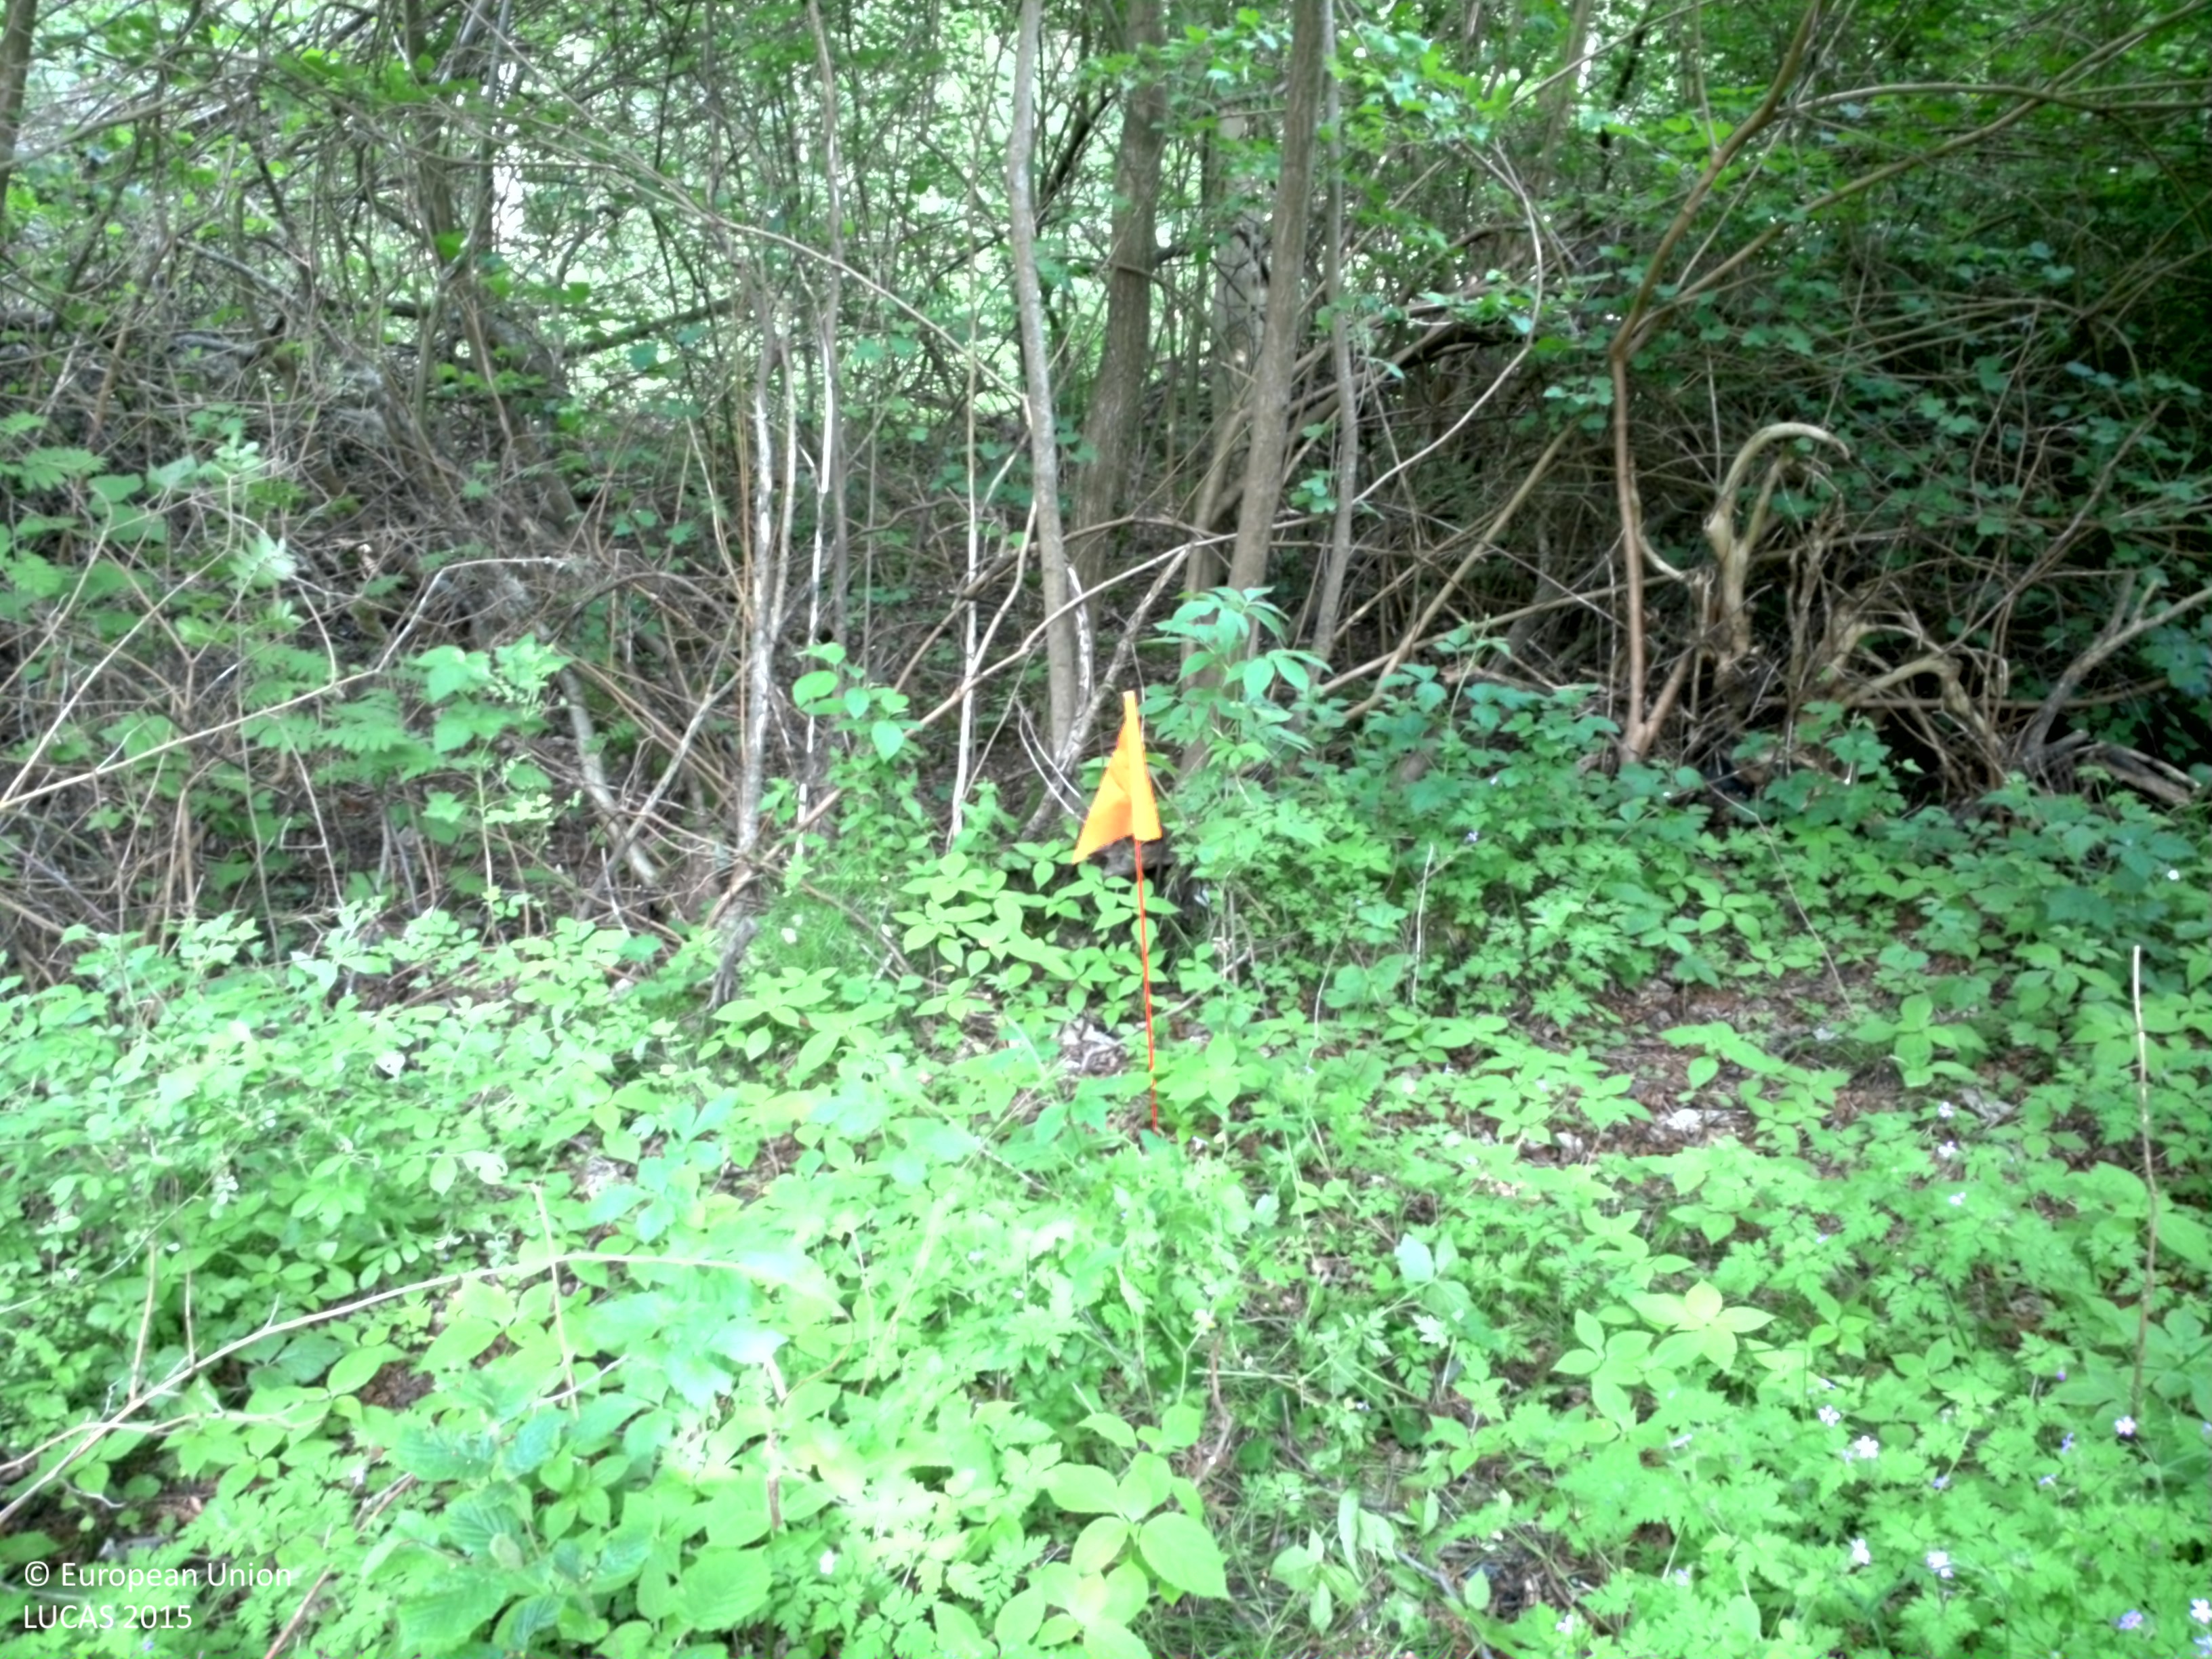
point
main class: Woodland
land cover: Broadleaved woodland
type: mesophytic deciduous forest
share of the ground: > 75 %
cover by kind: broadleaved forest trees 85 %, herbaceous plants 15 %
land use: Amenities, museums, leisure
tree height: > 5 m
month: June
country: SE
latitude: 55.7732
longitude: 13.0745
